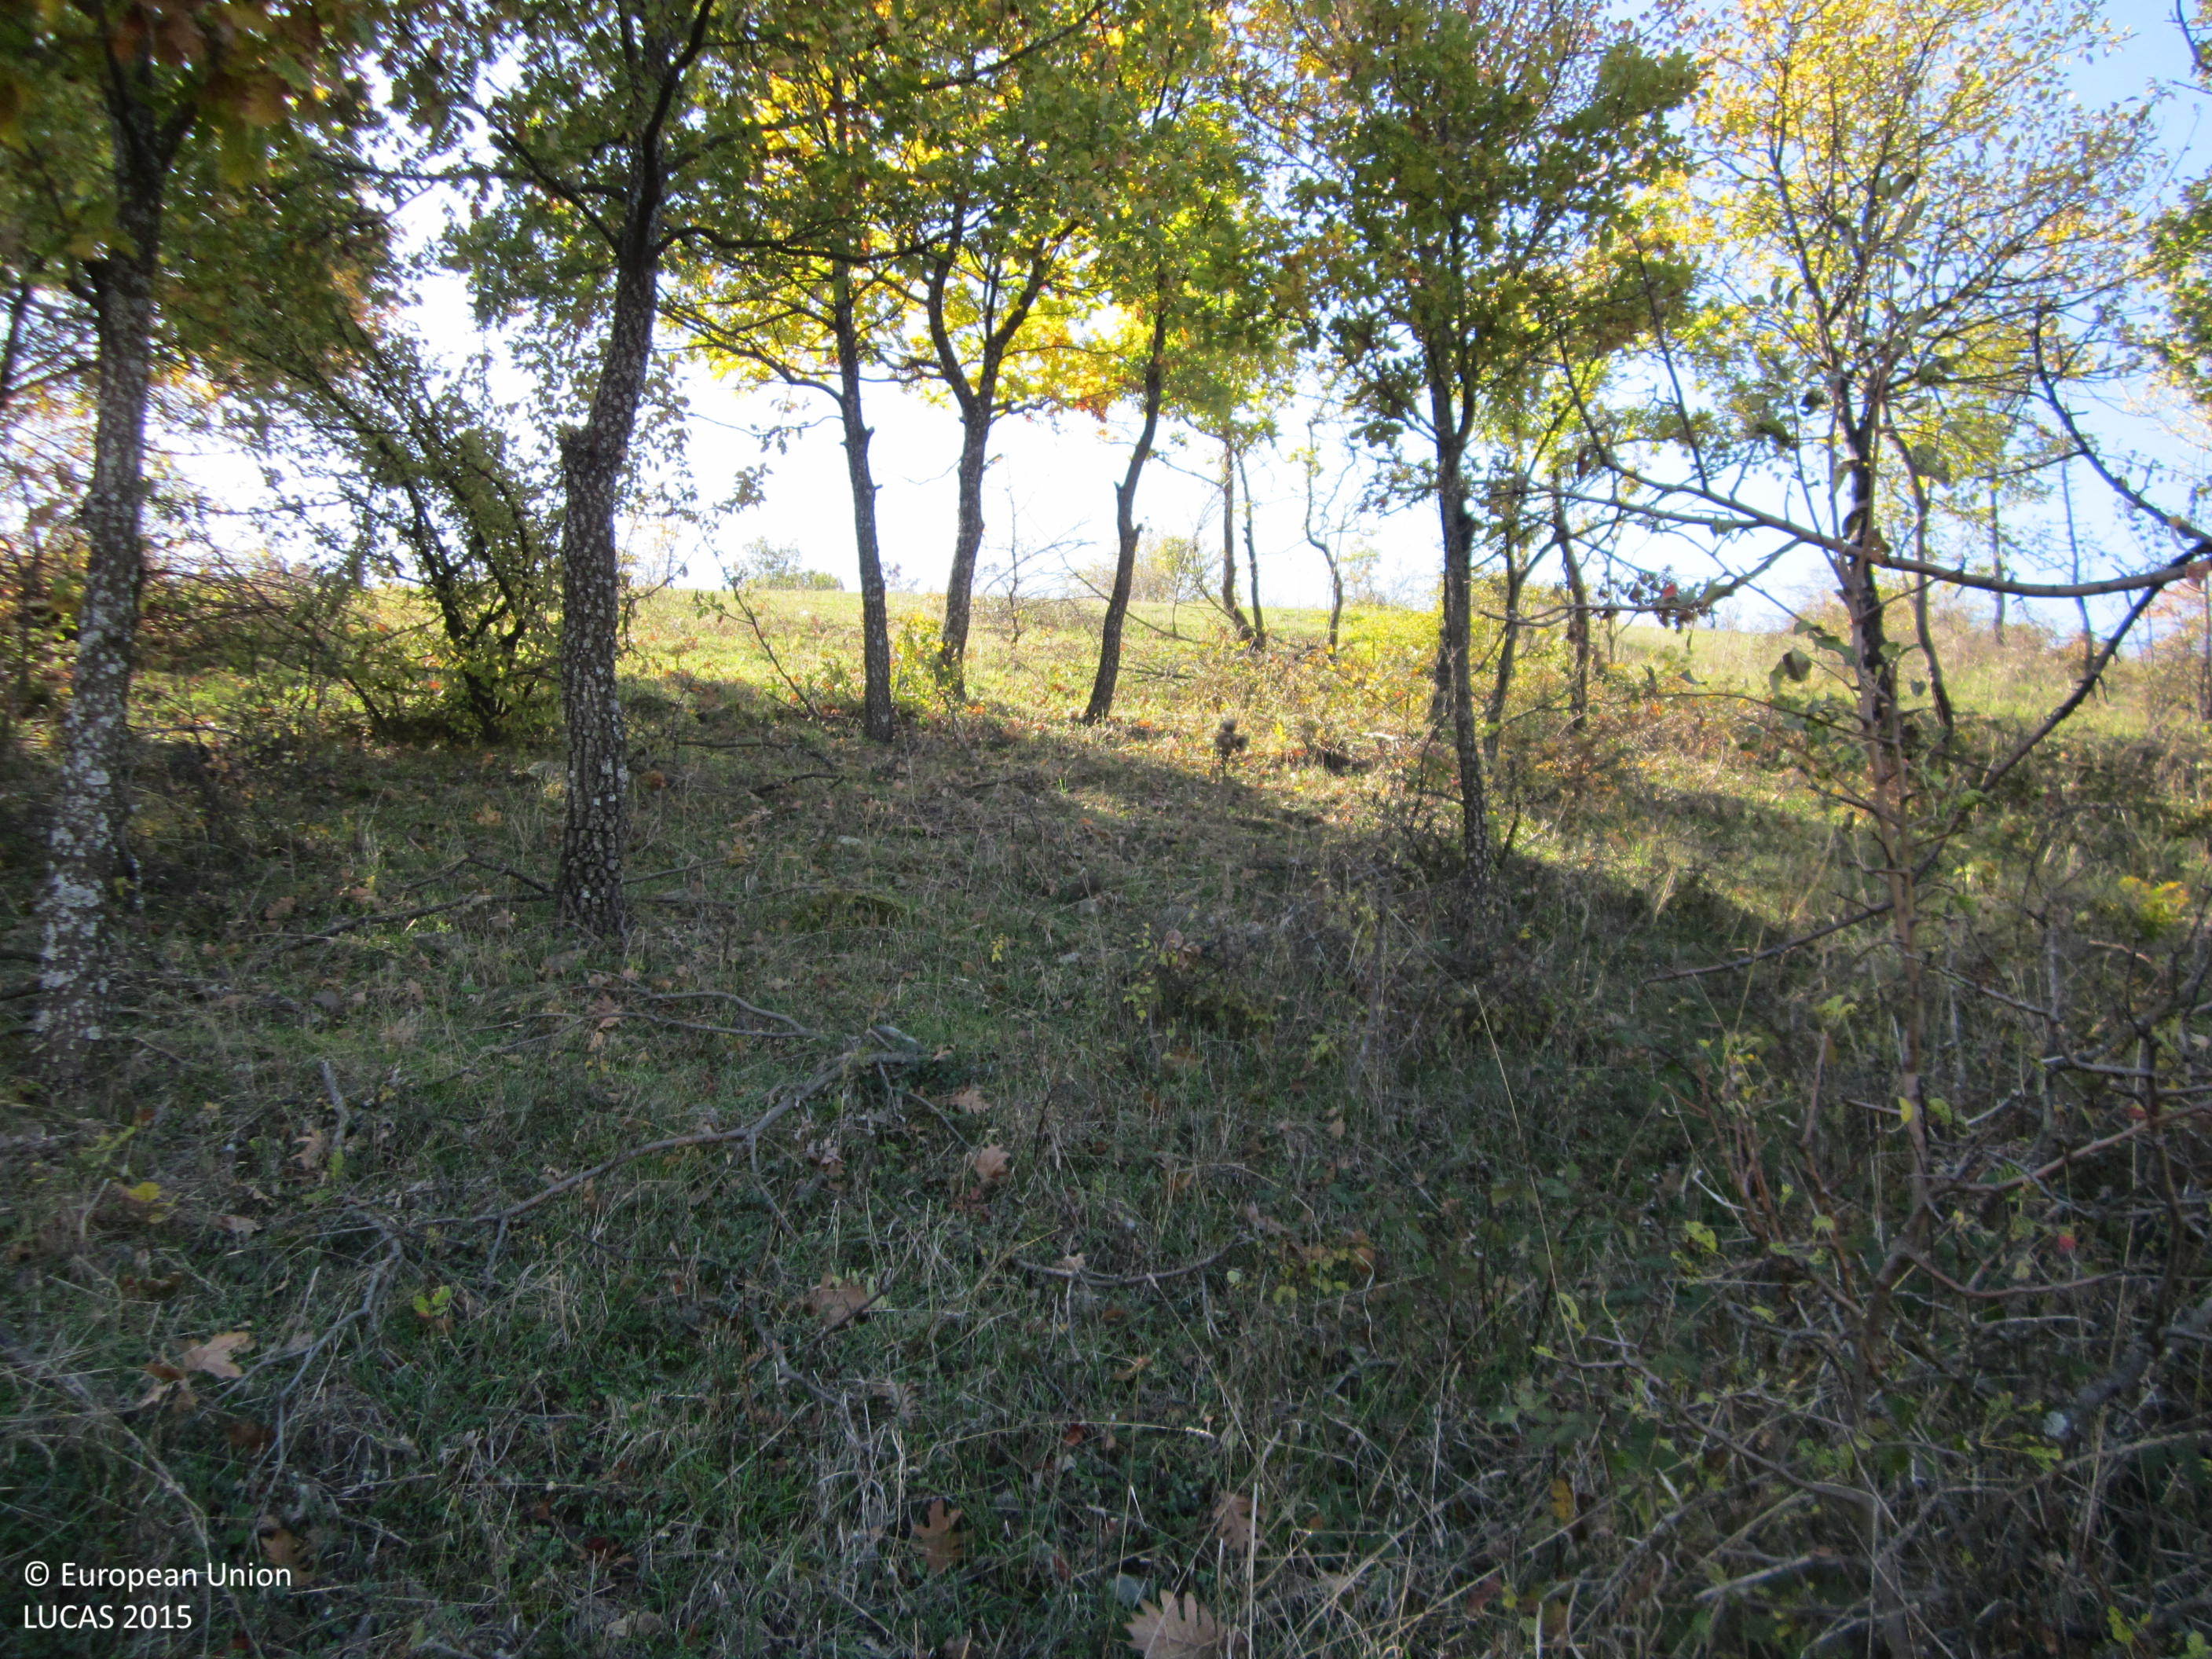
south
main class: Woodland
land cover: Broadleaved woodland
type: acidophilous oak and oak-birch forest
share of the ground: 50 - 75 %
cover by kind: broadleaved forest trees 60 %, herbaceous plants 30 %, shrubs 10 %
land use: Forestry
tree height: > 5 m
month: November
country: BG
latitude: 41.5315
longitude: 25.5805
